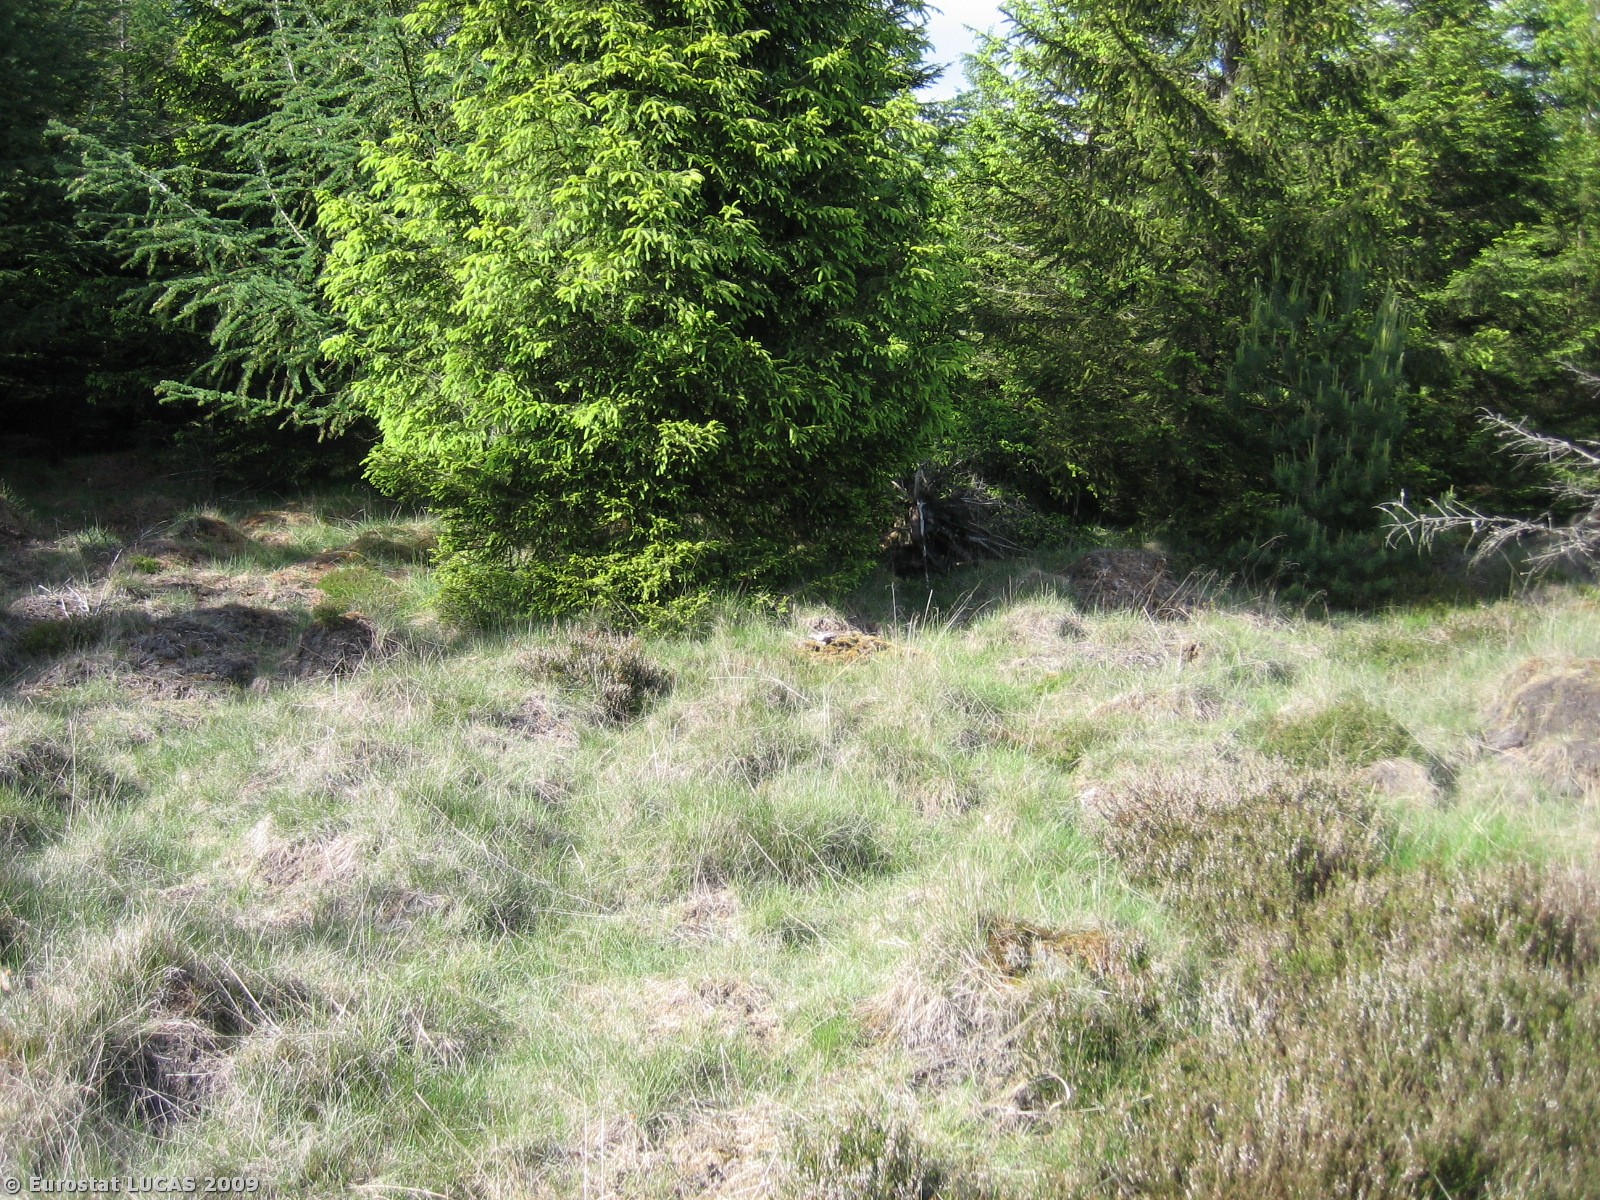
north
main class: Shrubland
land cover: Shrubland with sparse tree cover
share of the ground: > 75 %
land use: Forestry
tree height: > 5 m
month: May
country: DK
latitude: 56.0574
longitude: 8.9253
